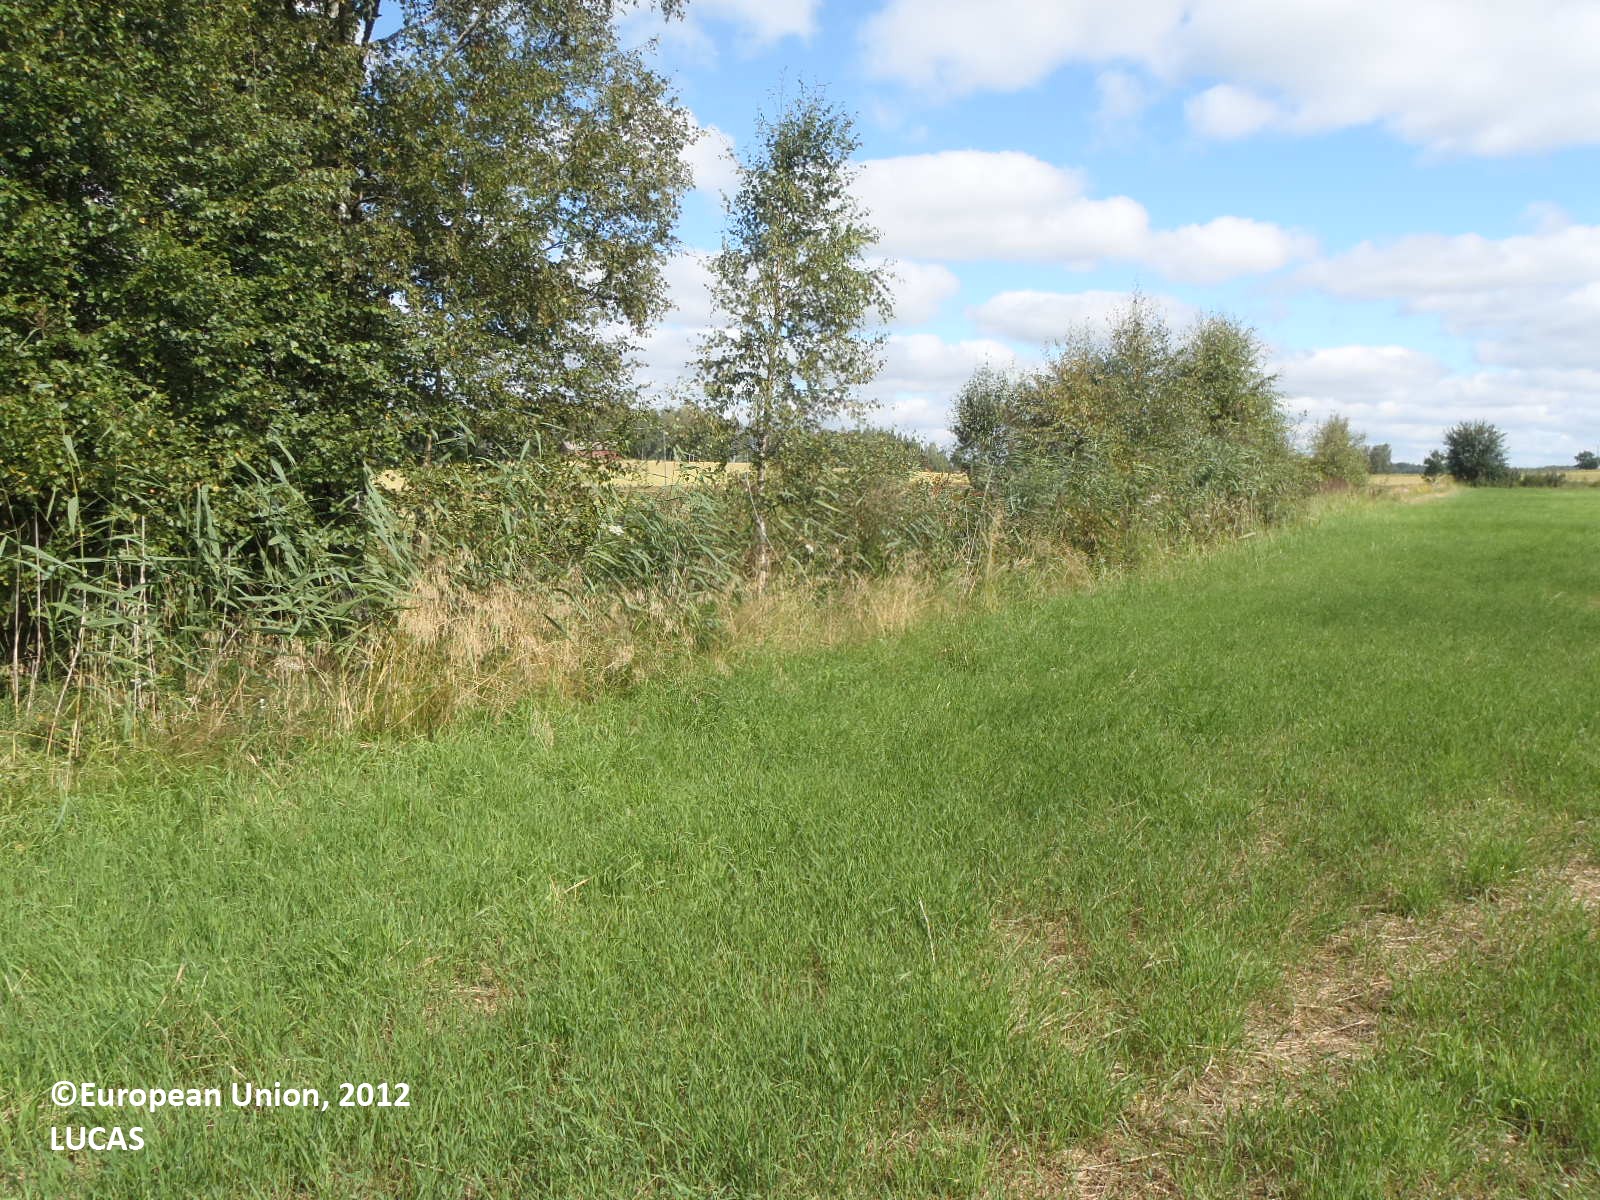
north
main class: Cropland
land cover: Temporary grasslands
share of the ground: > 75 %
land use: Agriculture (excluding fallow land and kitchen gardens)
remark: Harvested field
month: August
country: FI
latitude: 60.3953
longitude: 22.4279
